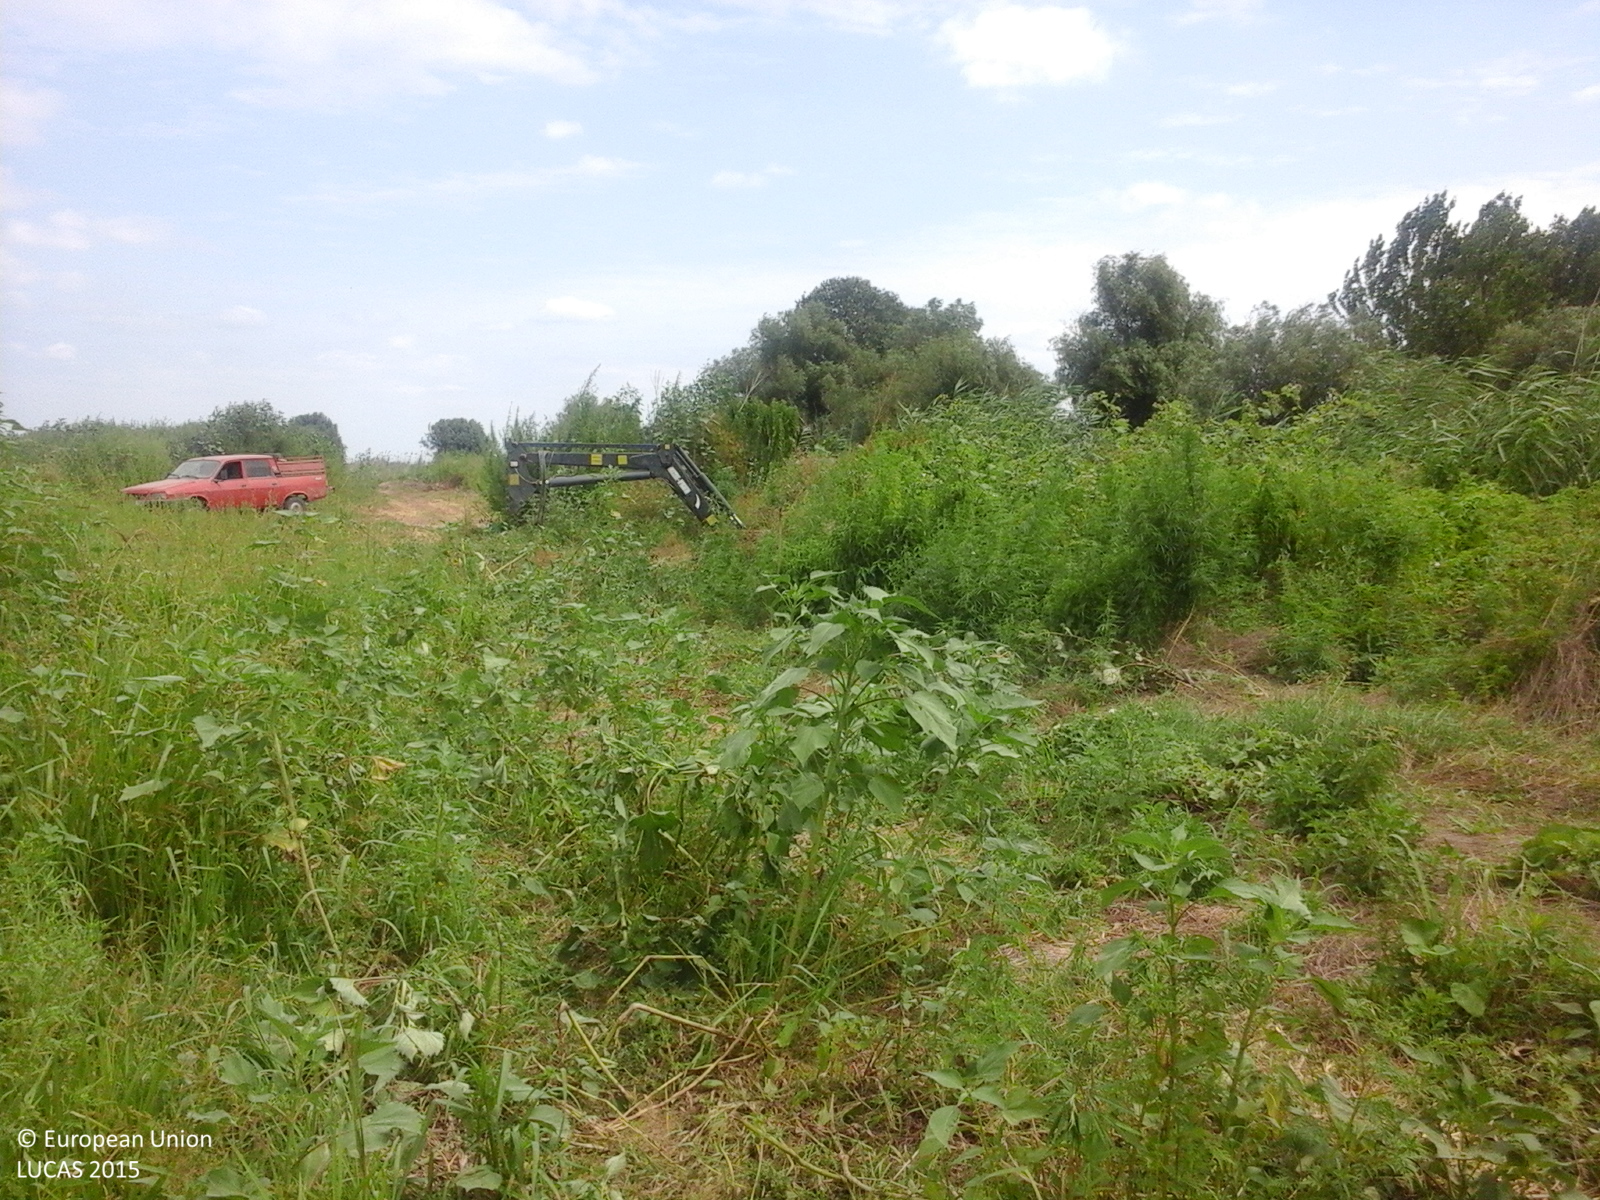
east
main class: Cropland
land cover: Sunflower
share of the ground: > 75 %
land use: Agriculture (excluding fallow land and kitchen gardens)
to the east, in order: Sunflower
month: August
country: RO
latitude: 45.2779
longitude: 29.0820
